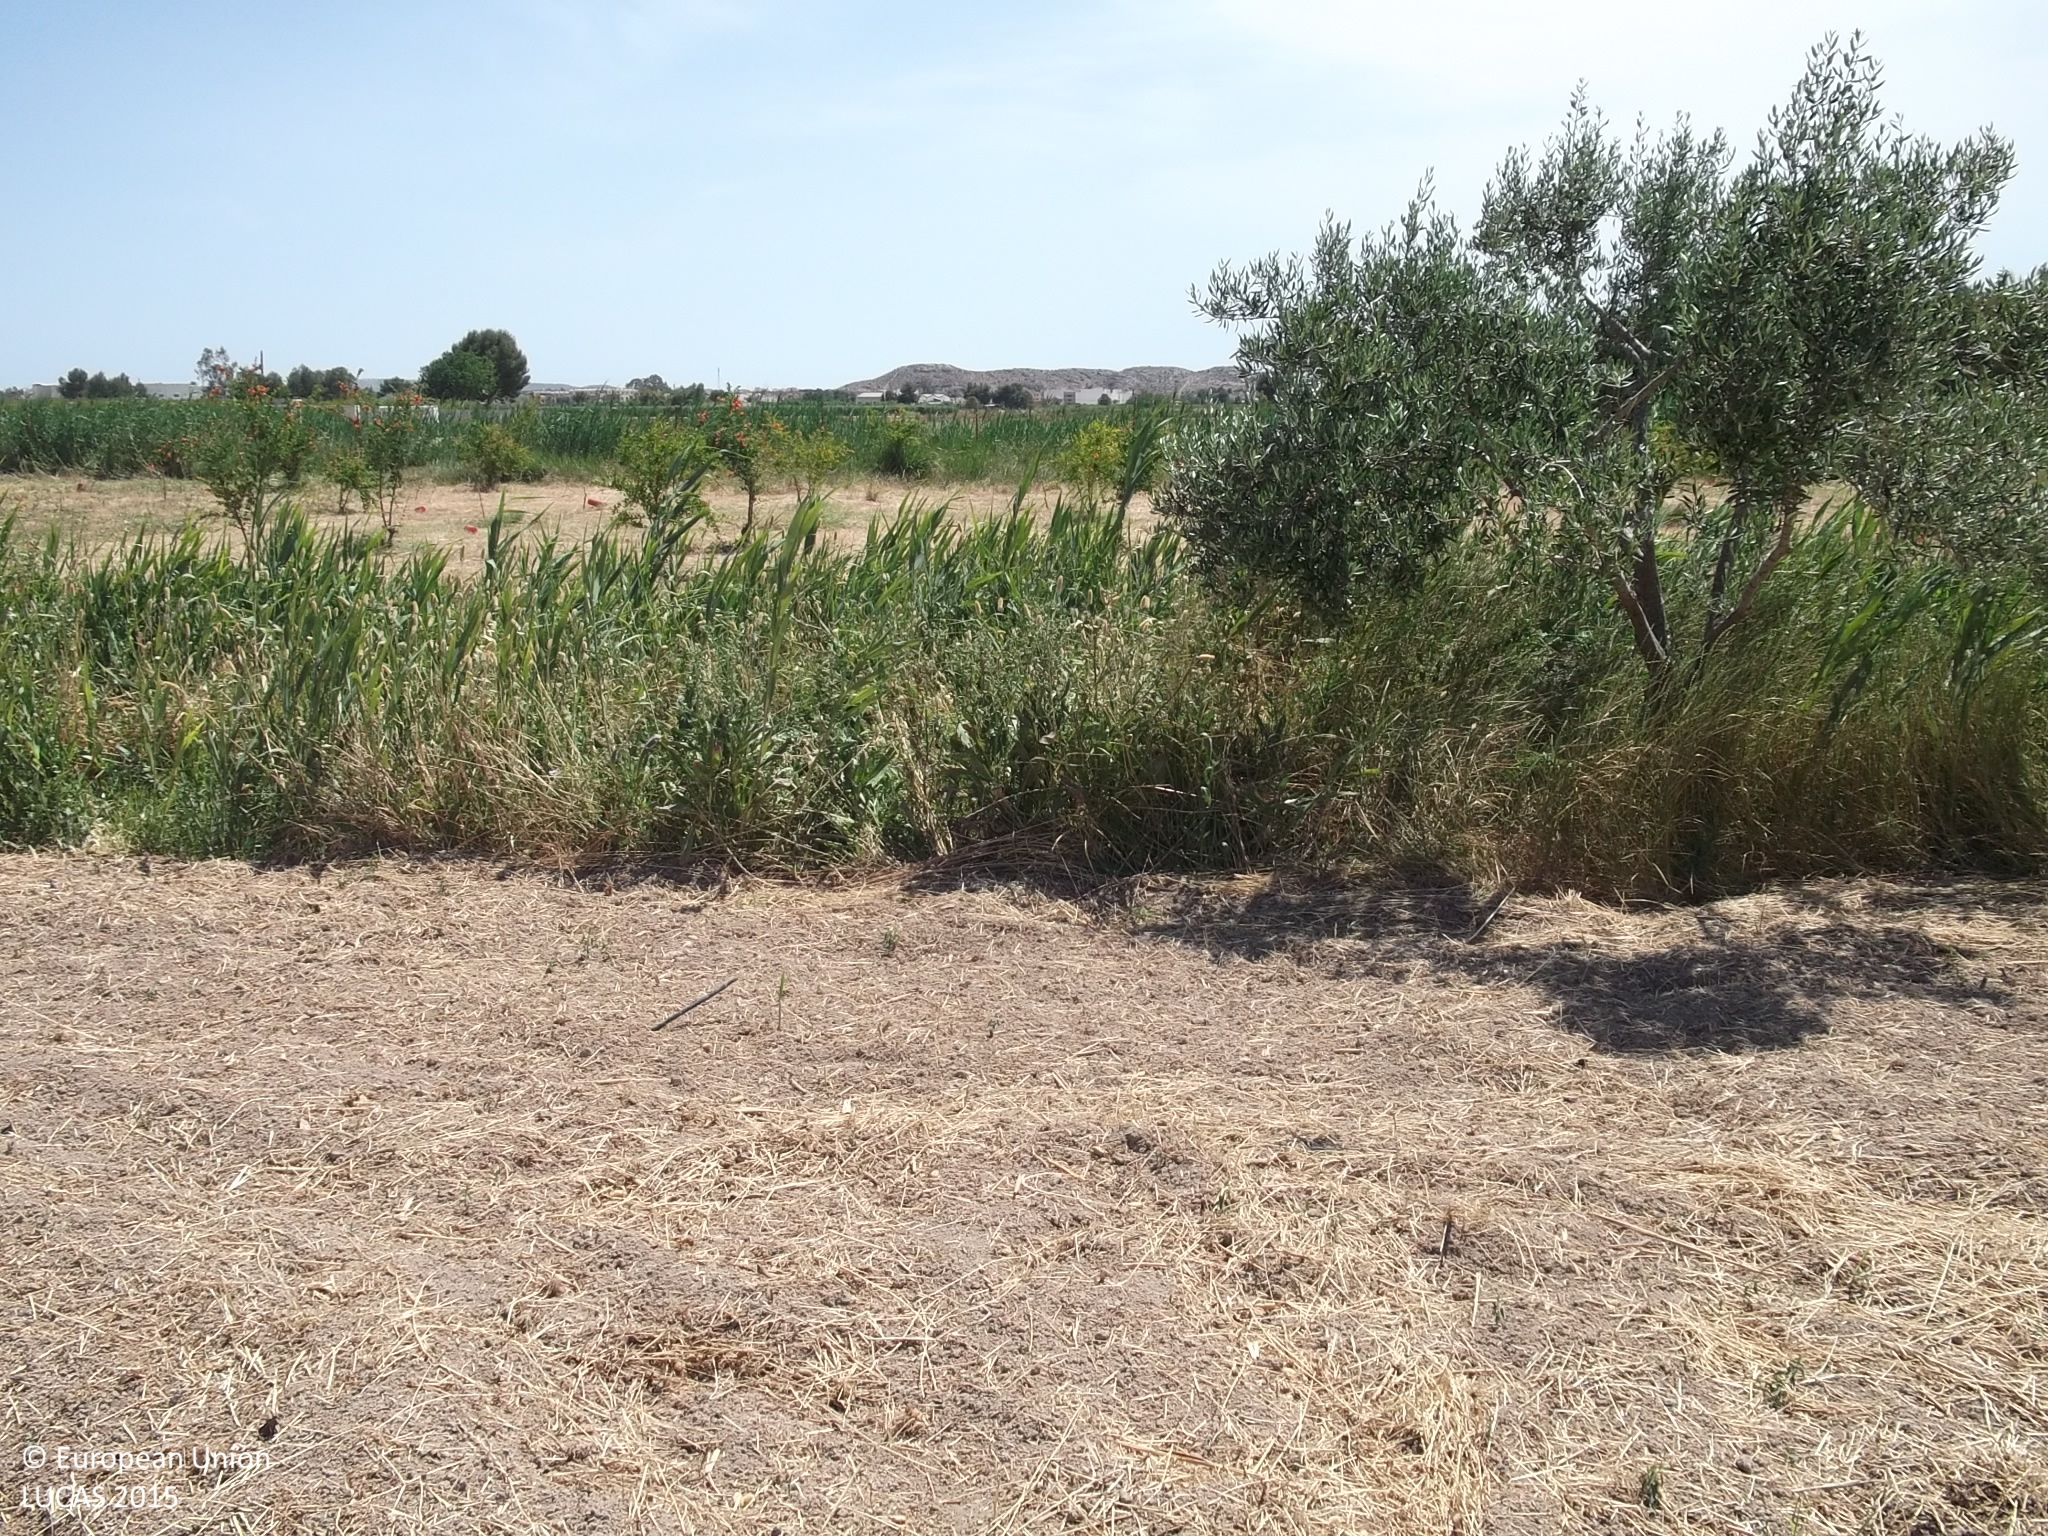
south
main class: Cropland
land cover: Other fruit trees and berries
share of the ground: < 10 %
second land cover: Other bare soil
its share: > 75 %
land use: Agriculture (excluding fallow land and kitchen gardens)
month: May
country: ES
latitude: 38.1859
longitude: -0.8424
